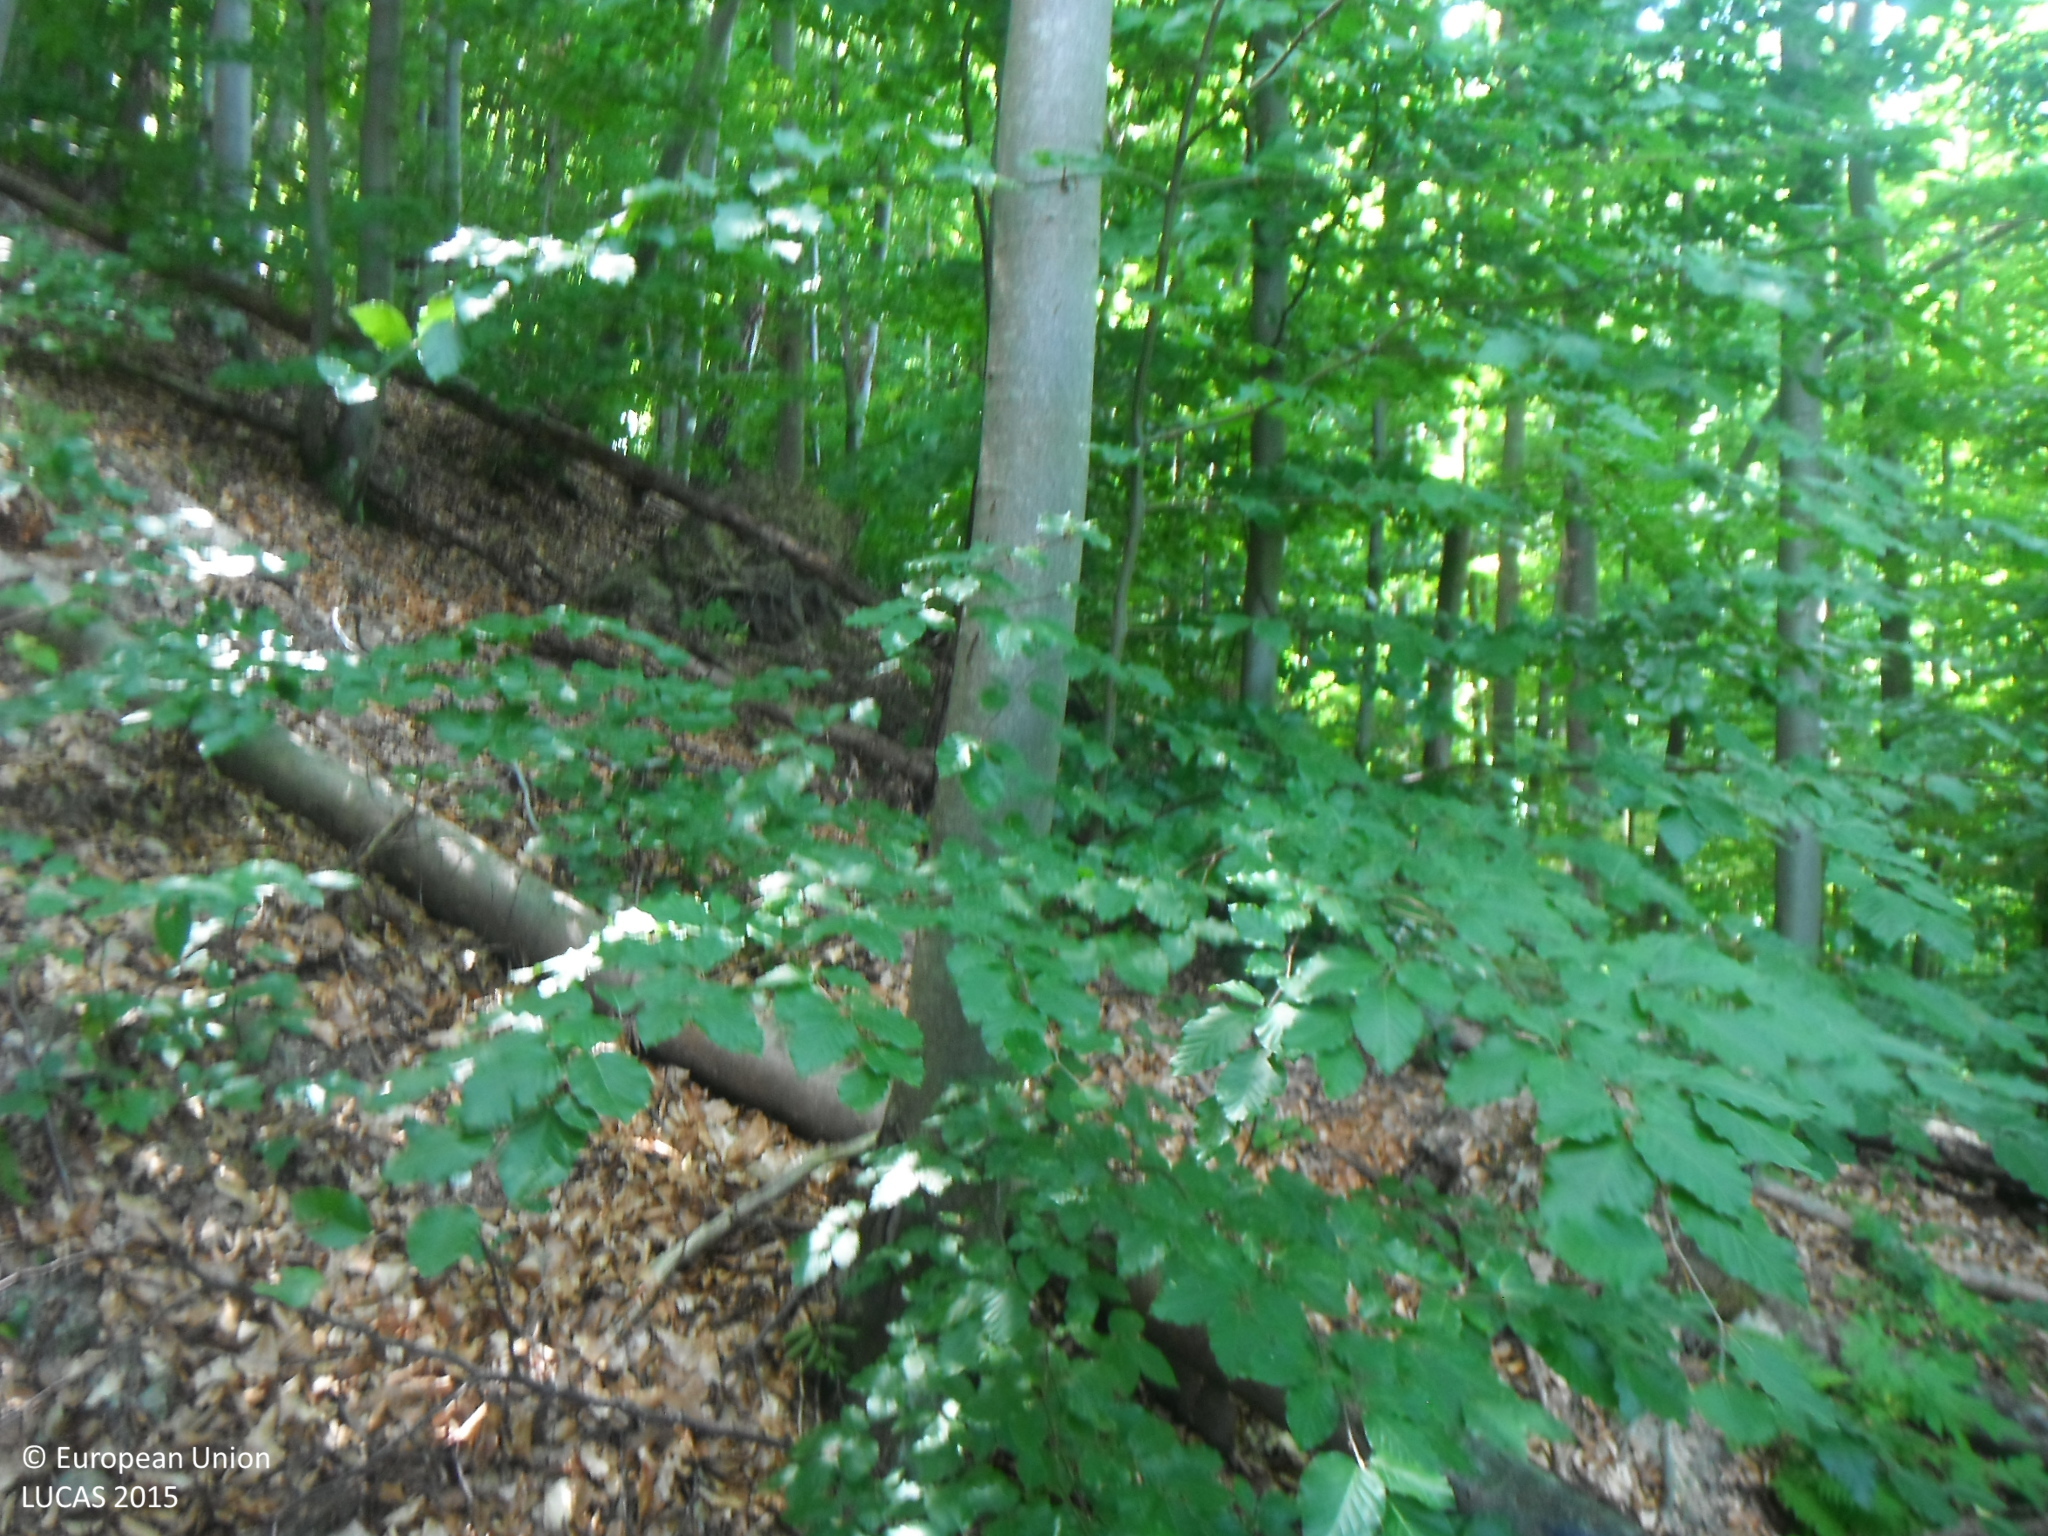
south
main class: Woodland
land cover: Broadleaved woodland
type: beech forest
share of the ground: > 75 %
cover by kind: broadleaved forest trees 100 %
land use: Forestry
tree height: > 5 m
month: July
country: SK
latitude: 48.9972
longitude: 22.3762
